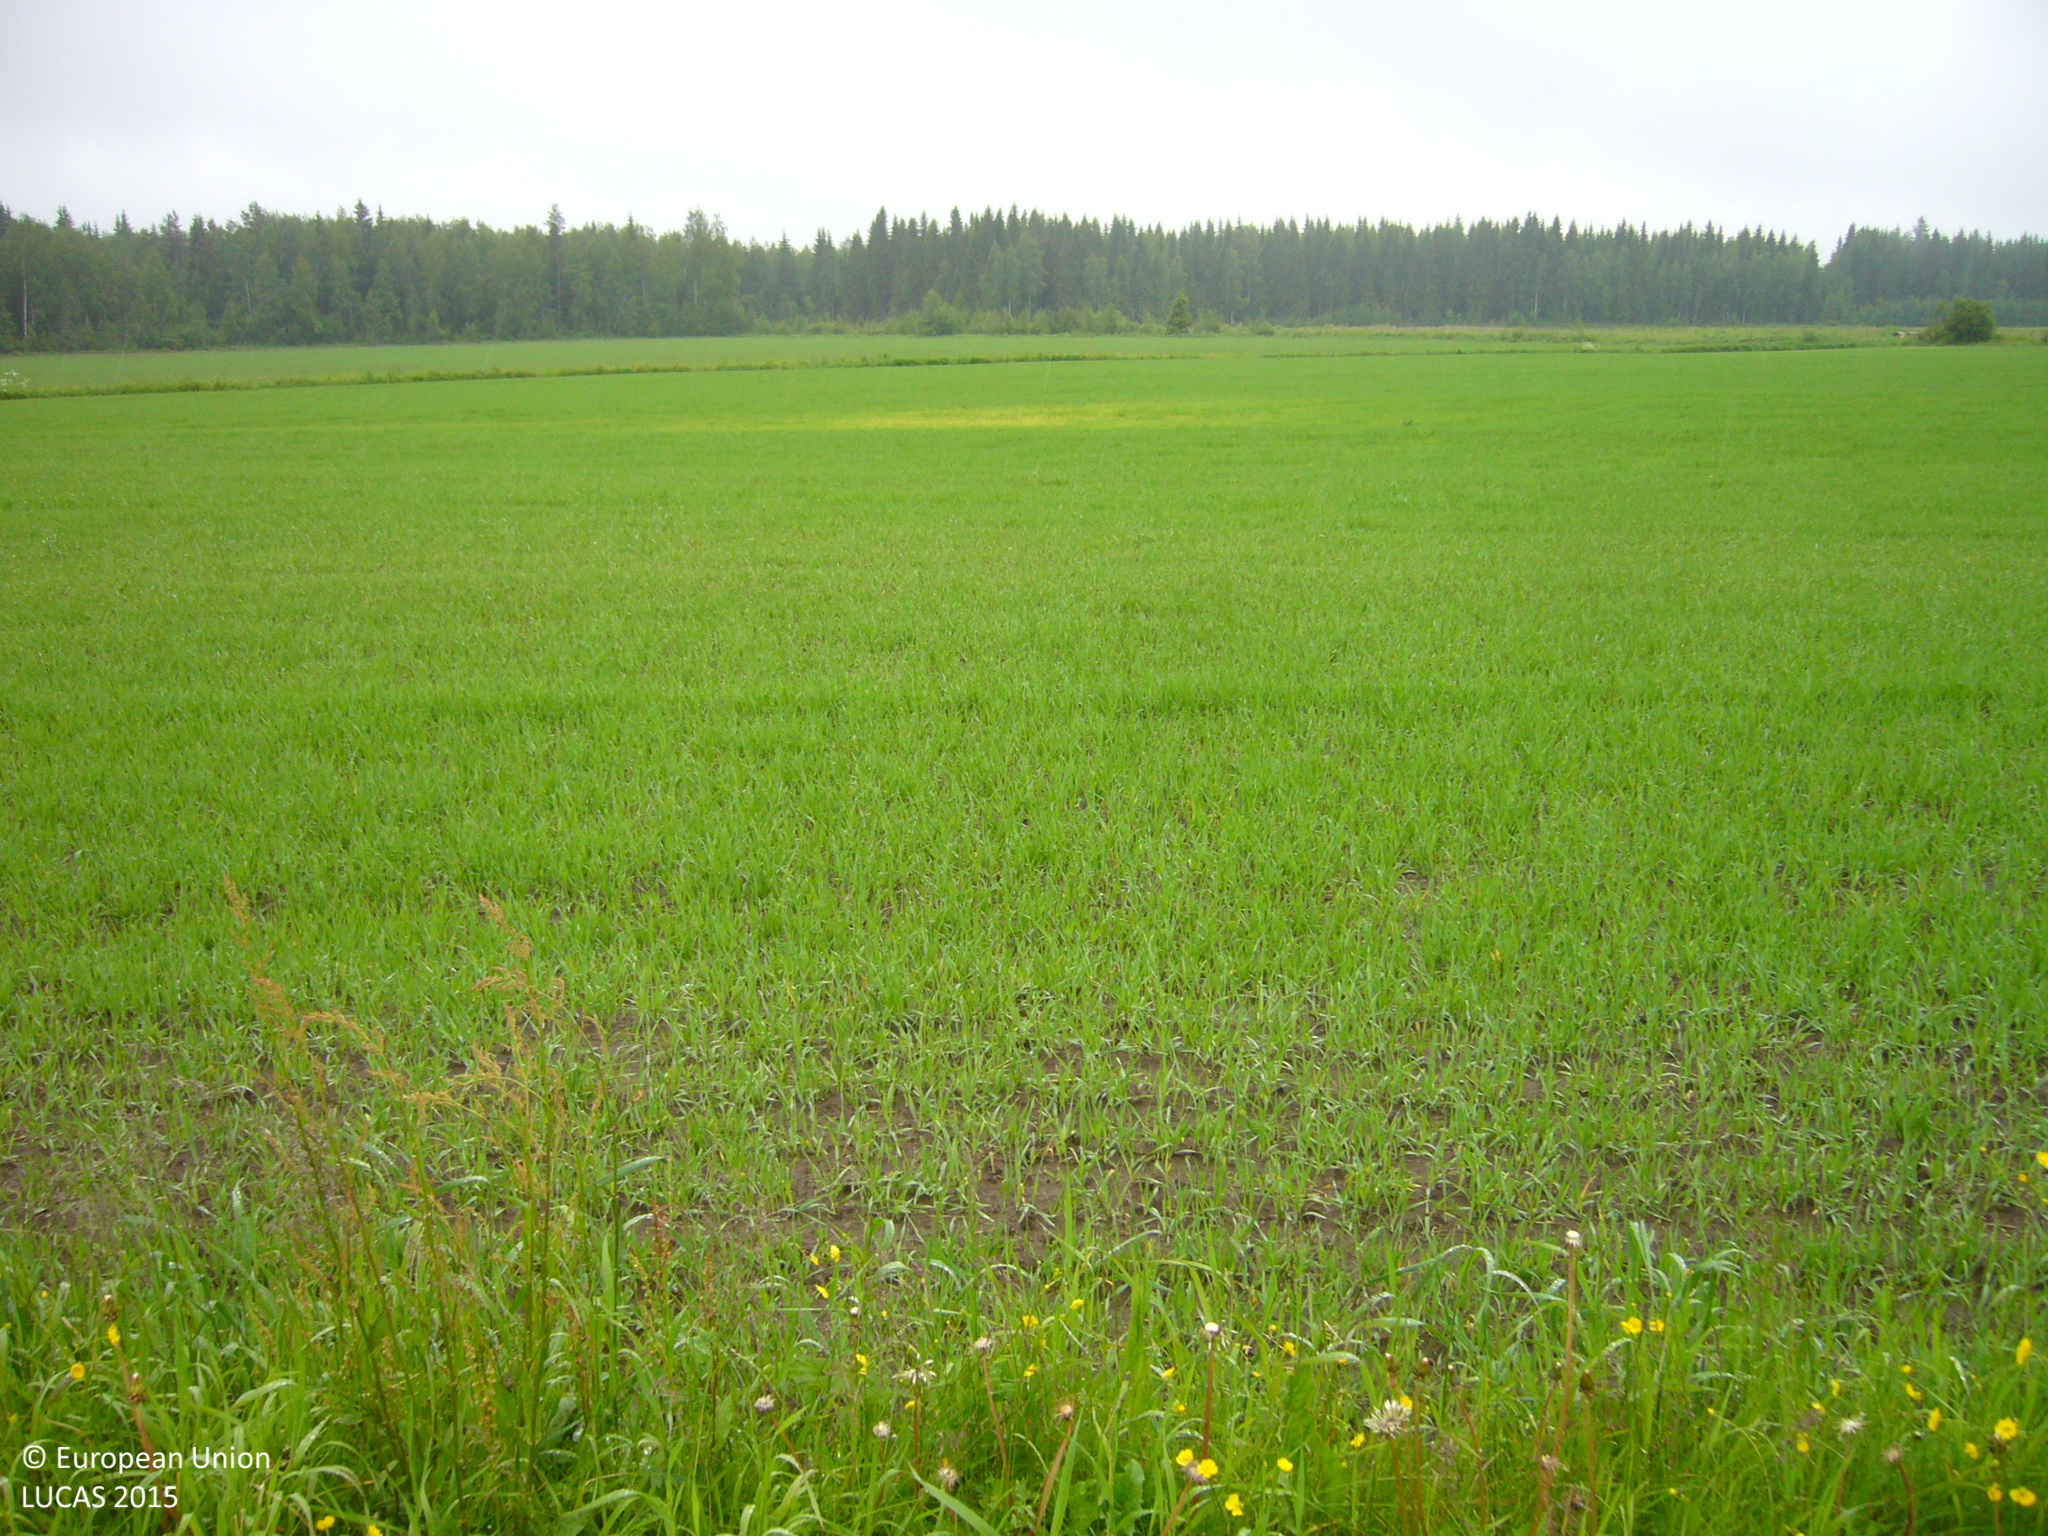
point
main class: Cropland
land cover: Barley
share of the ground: 50 - 75 %
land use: Agriculture (excluding fallow land and kitchen gardens)
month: June
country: FI
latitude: 63.7958
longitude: 25.1306
